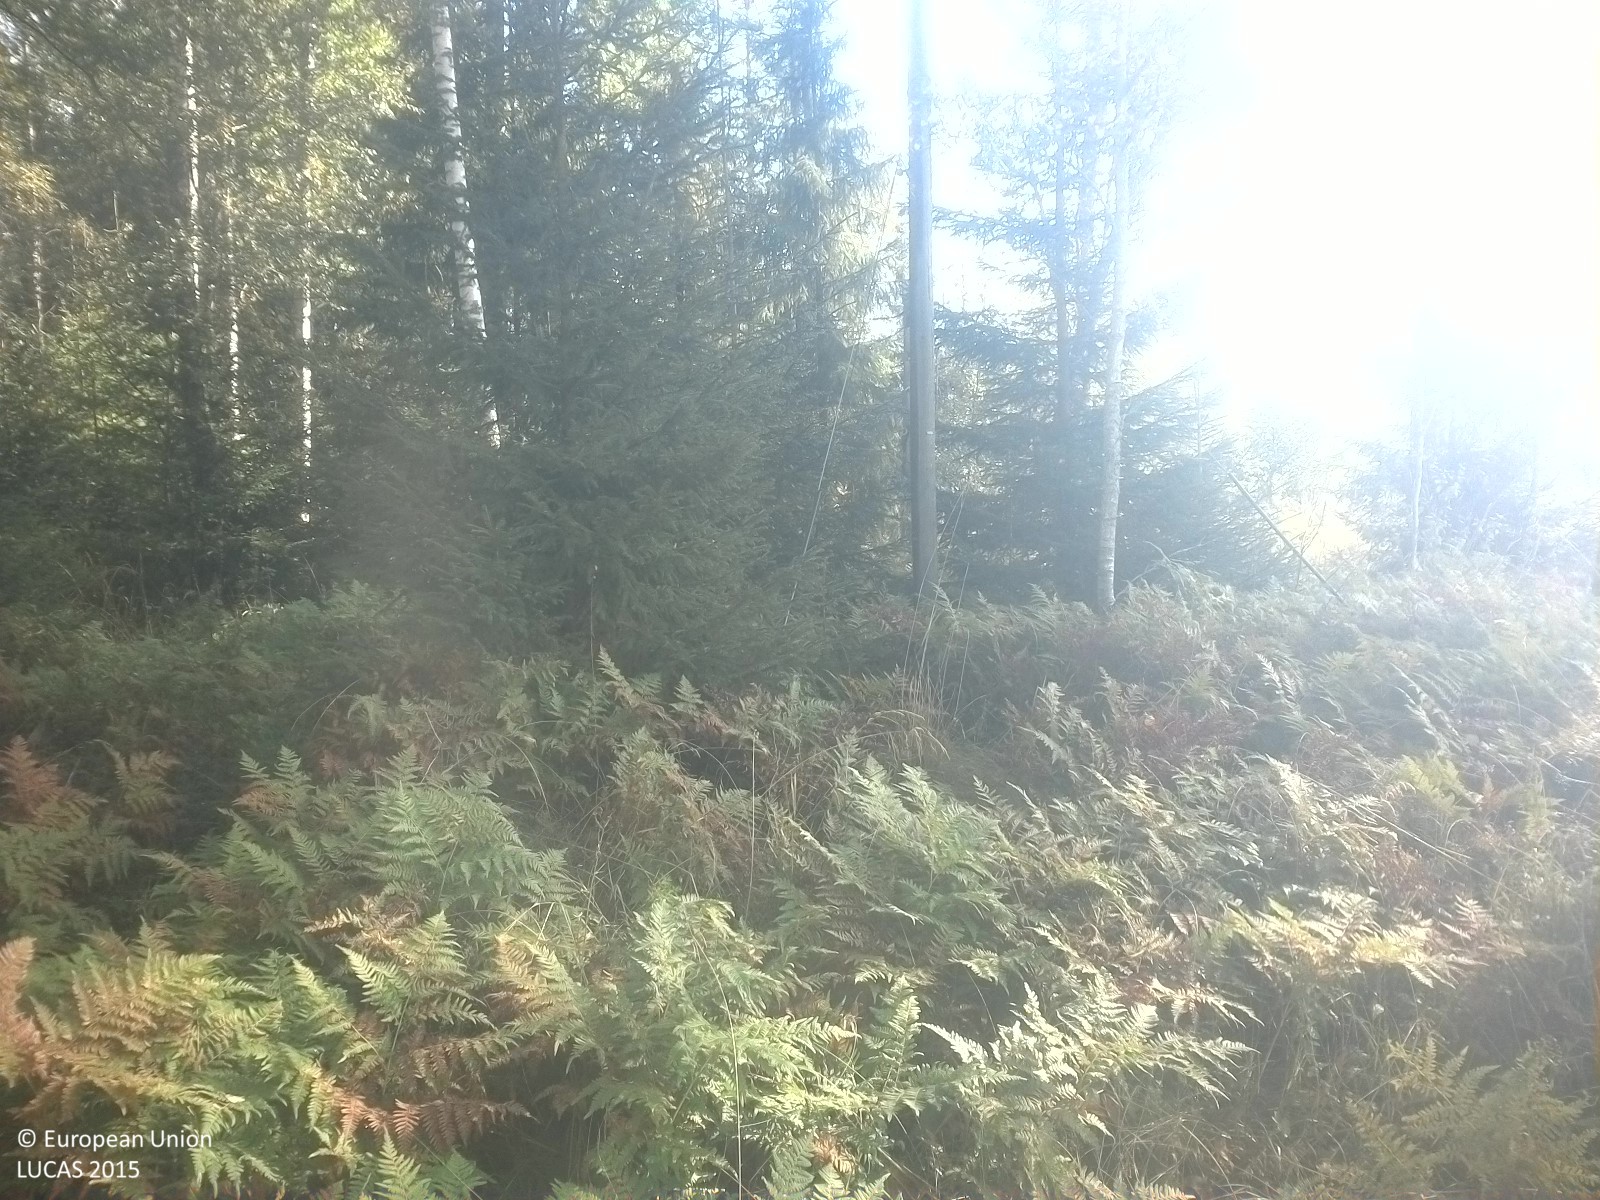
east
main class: Grassland
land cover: Spontaneously vegetated surfaces
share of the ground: > 75 %
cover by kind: herbaceous plants 100 %
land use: Semi-natural and natural areas not in use
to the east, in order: Spontaneously vegetated surfaces; Spruce dominated mixed woodland; Electric lines; Spruce dominated mixed woodland; Broadleaved woodland; Spruce dominated mixed woodland; Spruce dominated coniferous woodland; Spruce dominated mixed woodland
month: September
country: SE
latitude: 59.3597
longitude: 15.7442
